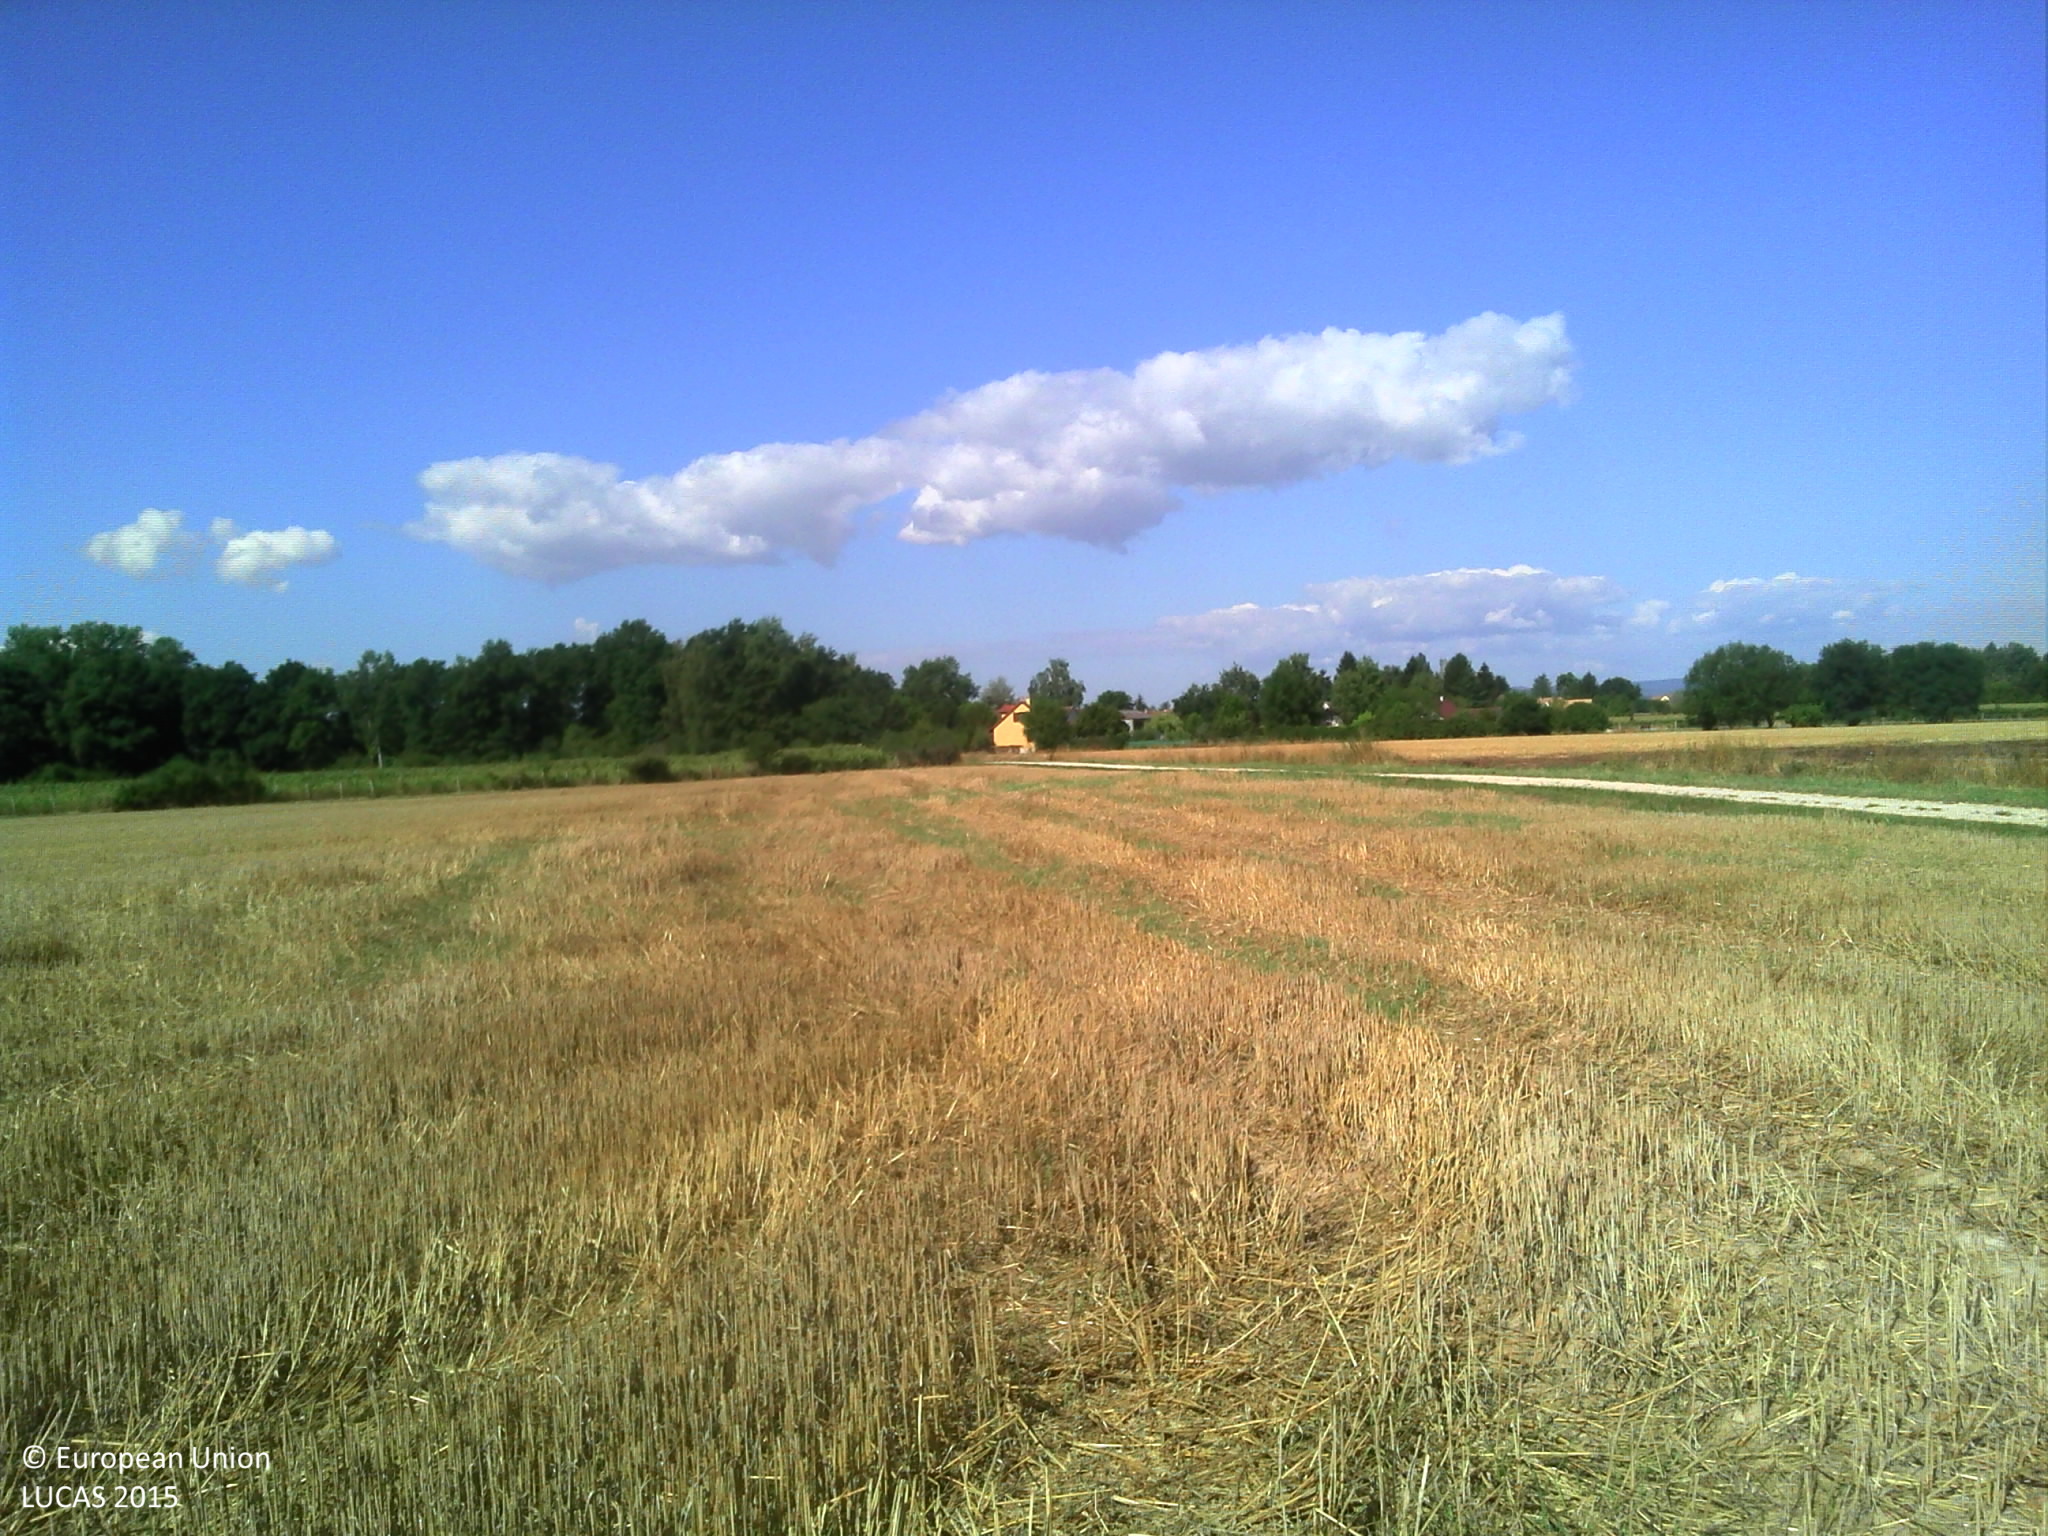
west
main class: Cropland
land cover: Common wheat
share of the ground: > 75 %
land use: Agriculture (excluding fallow land and kitchen gardens)
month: July
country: FR
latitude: 46.7725
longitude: 4.9334
